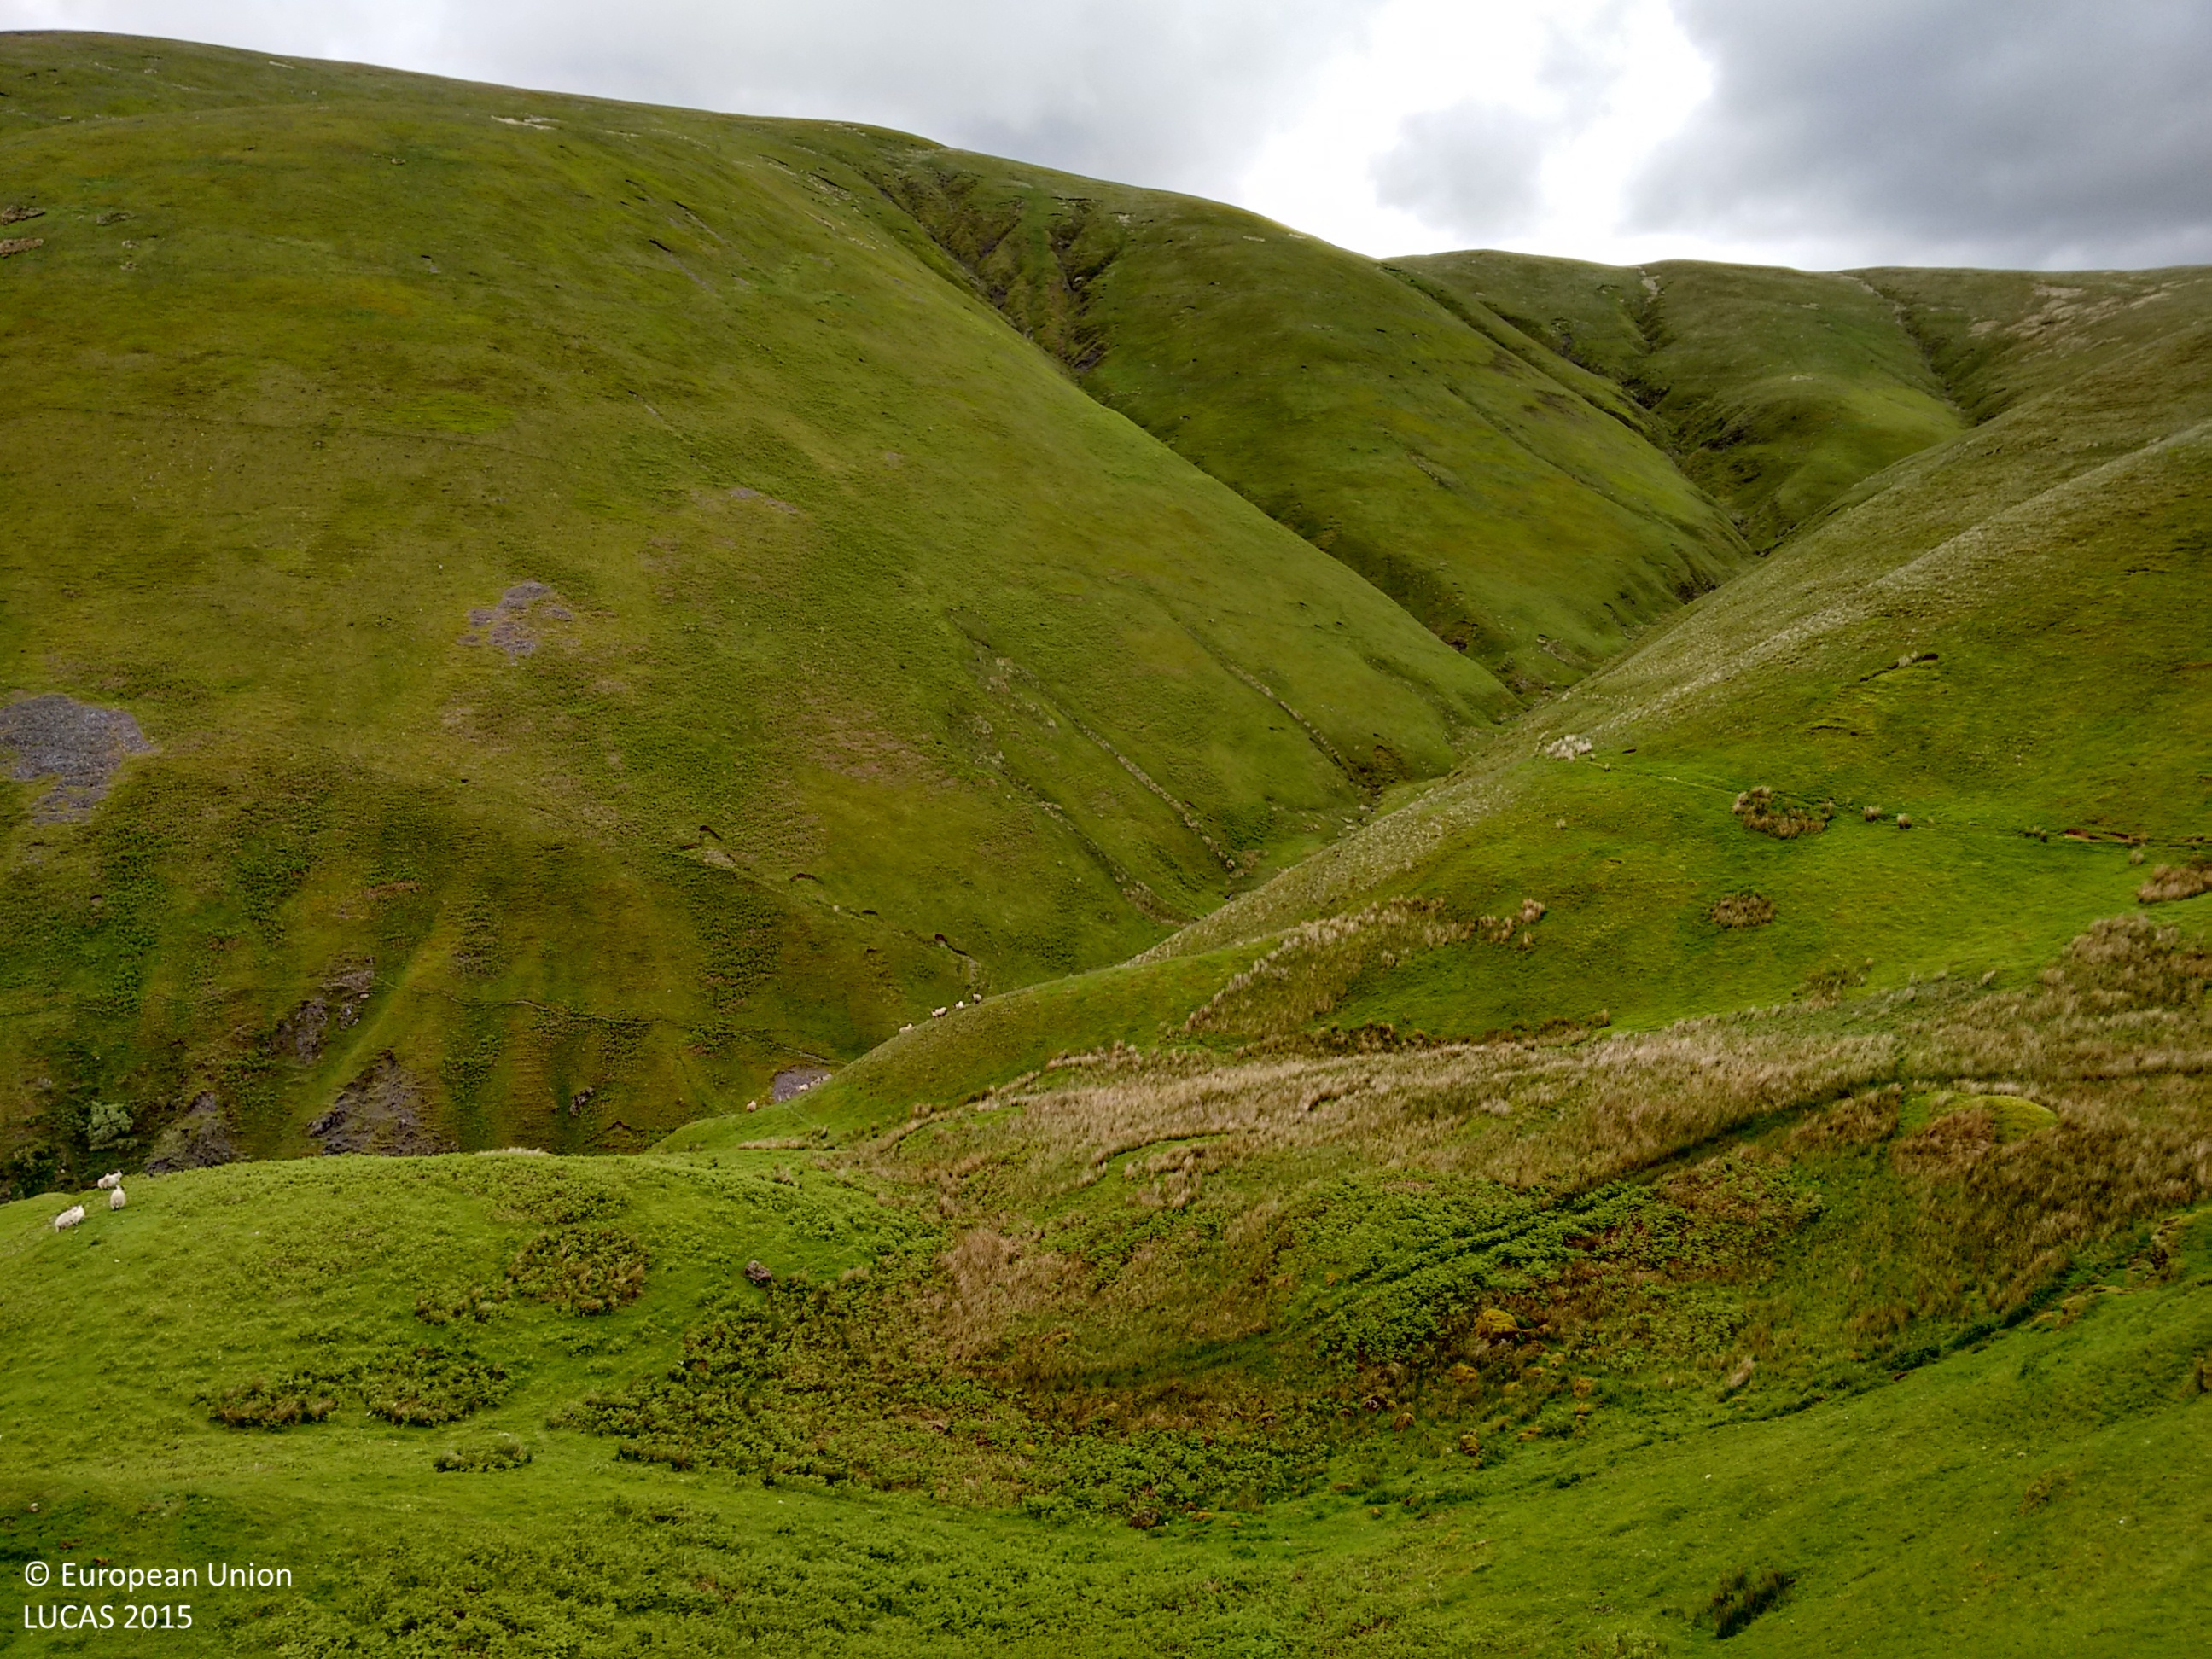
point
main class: Grassland
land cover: Grassland without tree/shrub cover
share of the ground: > 75 %
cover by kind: herbaceous plants 100 %
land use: Agriculture (excluding fallow land and kitchen gardens)
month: June
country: GB
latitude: 55.3505
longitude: -3.7581
